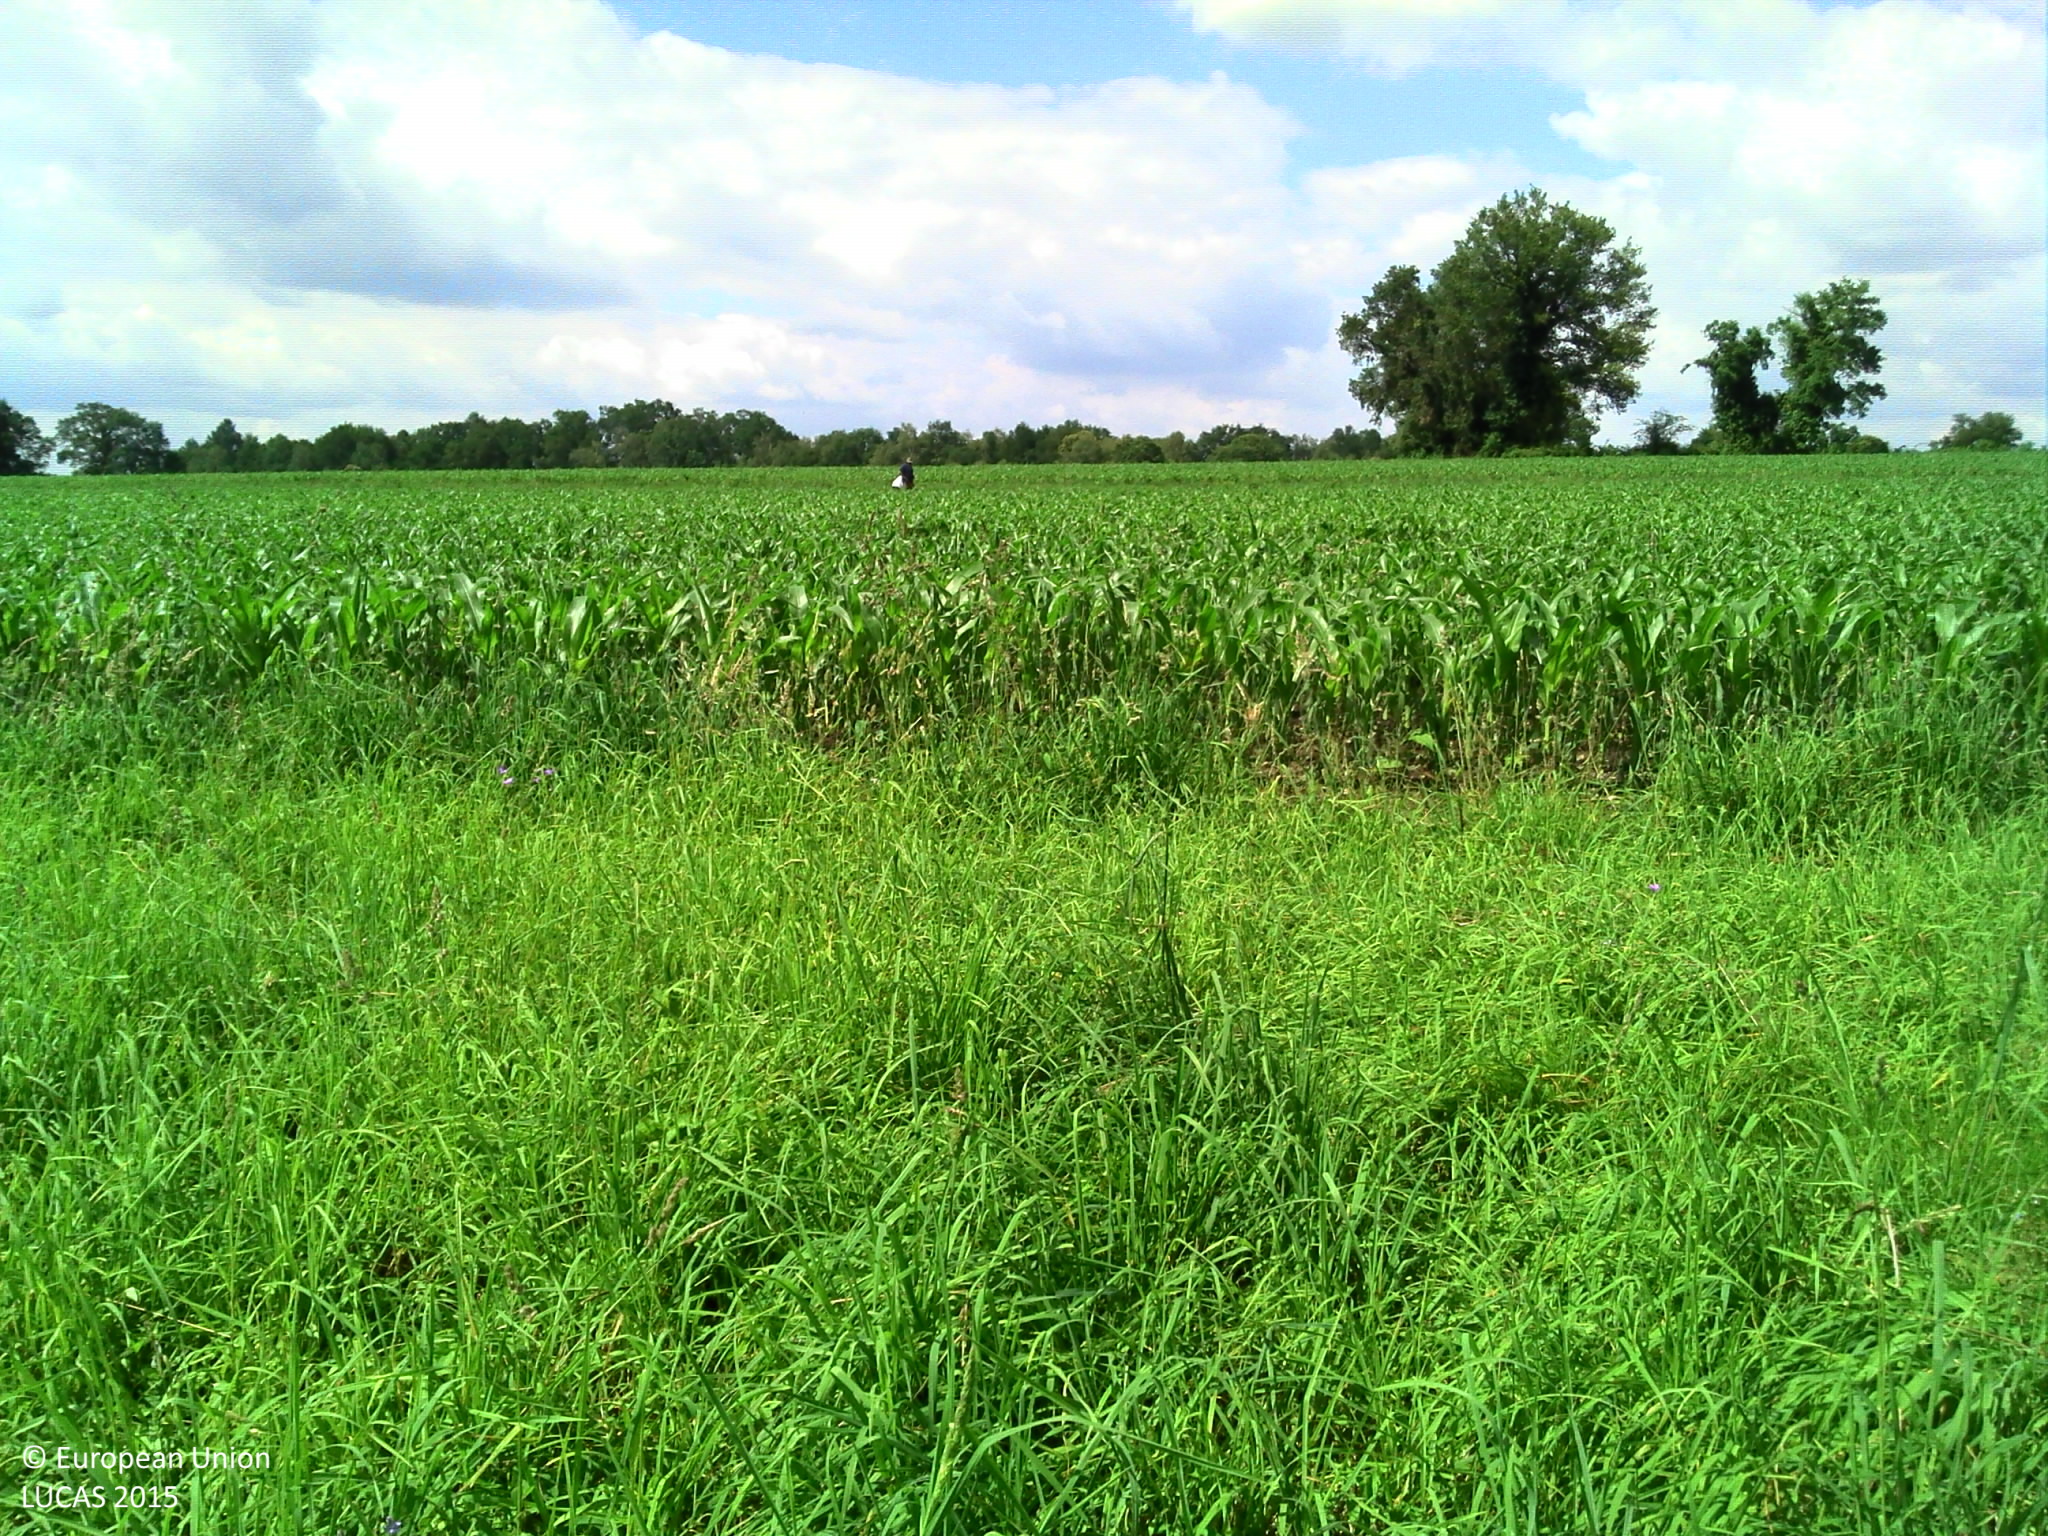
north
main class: Grassland
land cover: Grassland without tree/shrub cover
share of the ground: > 75 %
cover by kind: herbaceous plants 95 %, shrubs 5 %
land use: Agriculture (excluding fallow land and kitchen gardens)
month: June
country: FR
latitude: 43.2682
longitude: -0.1694
